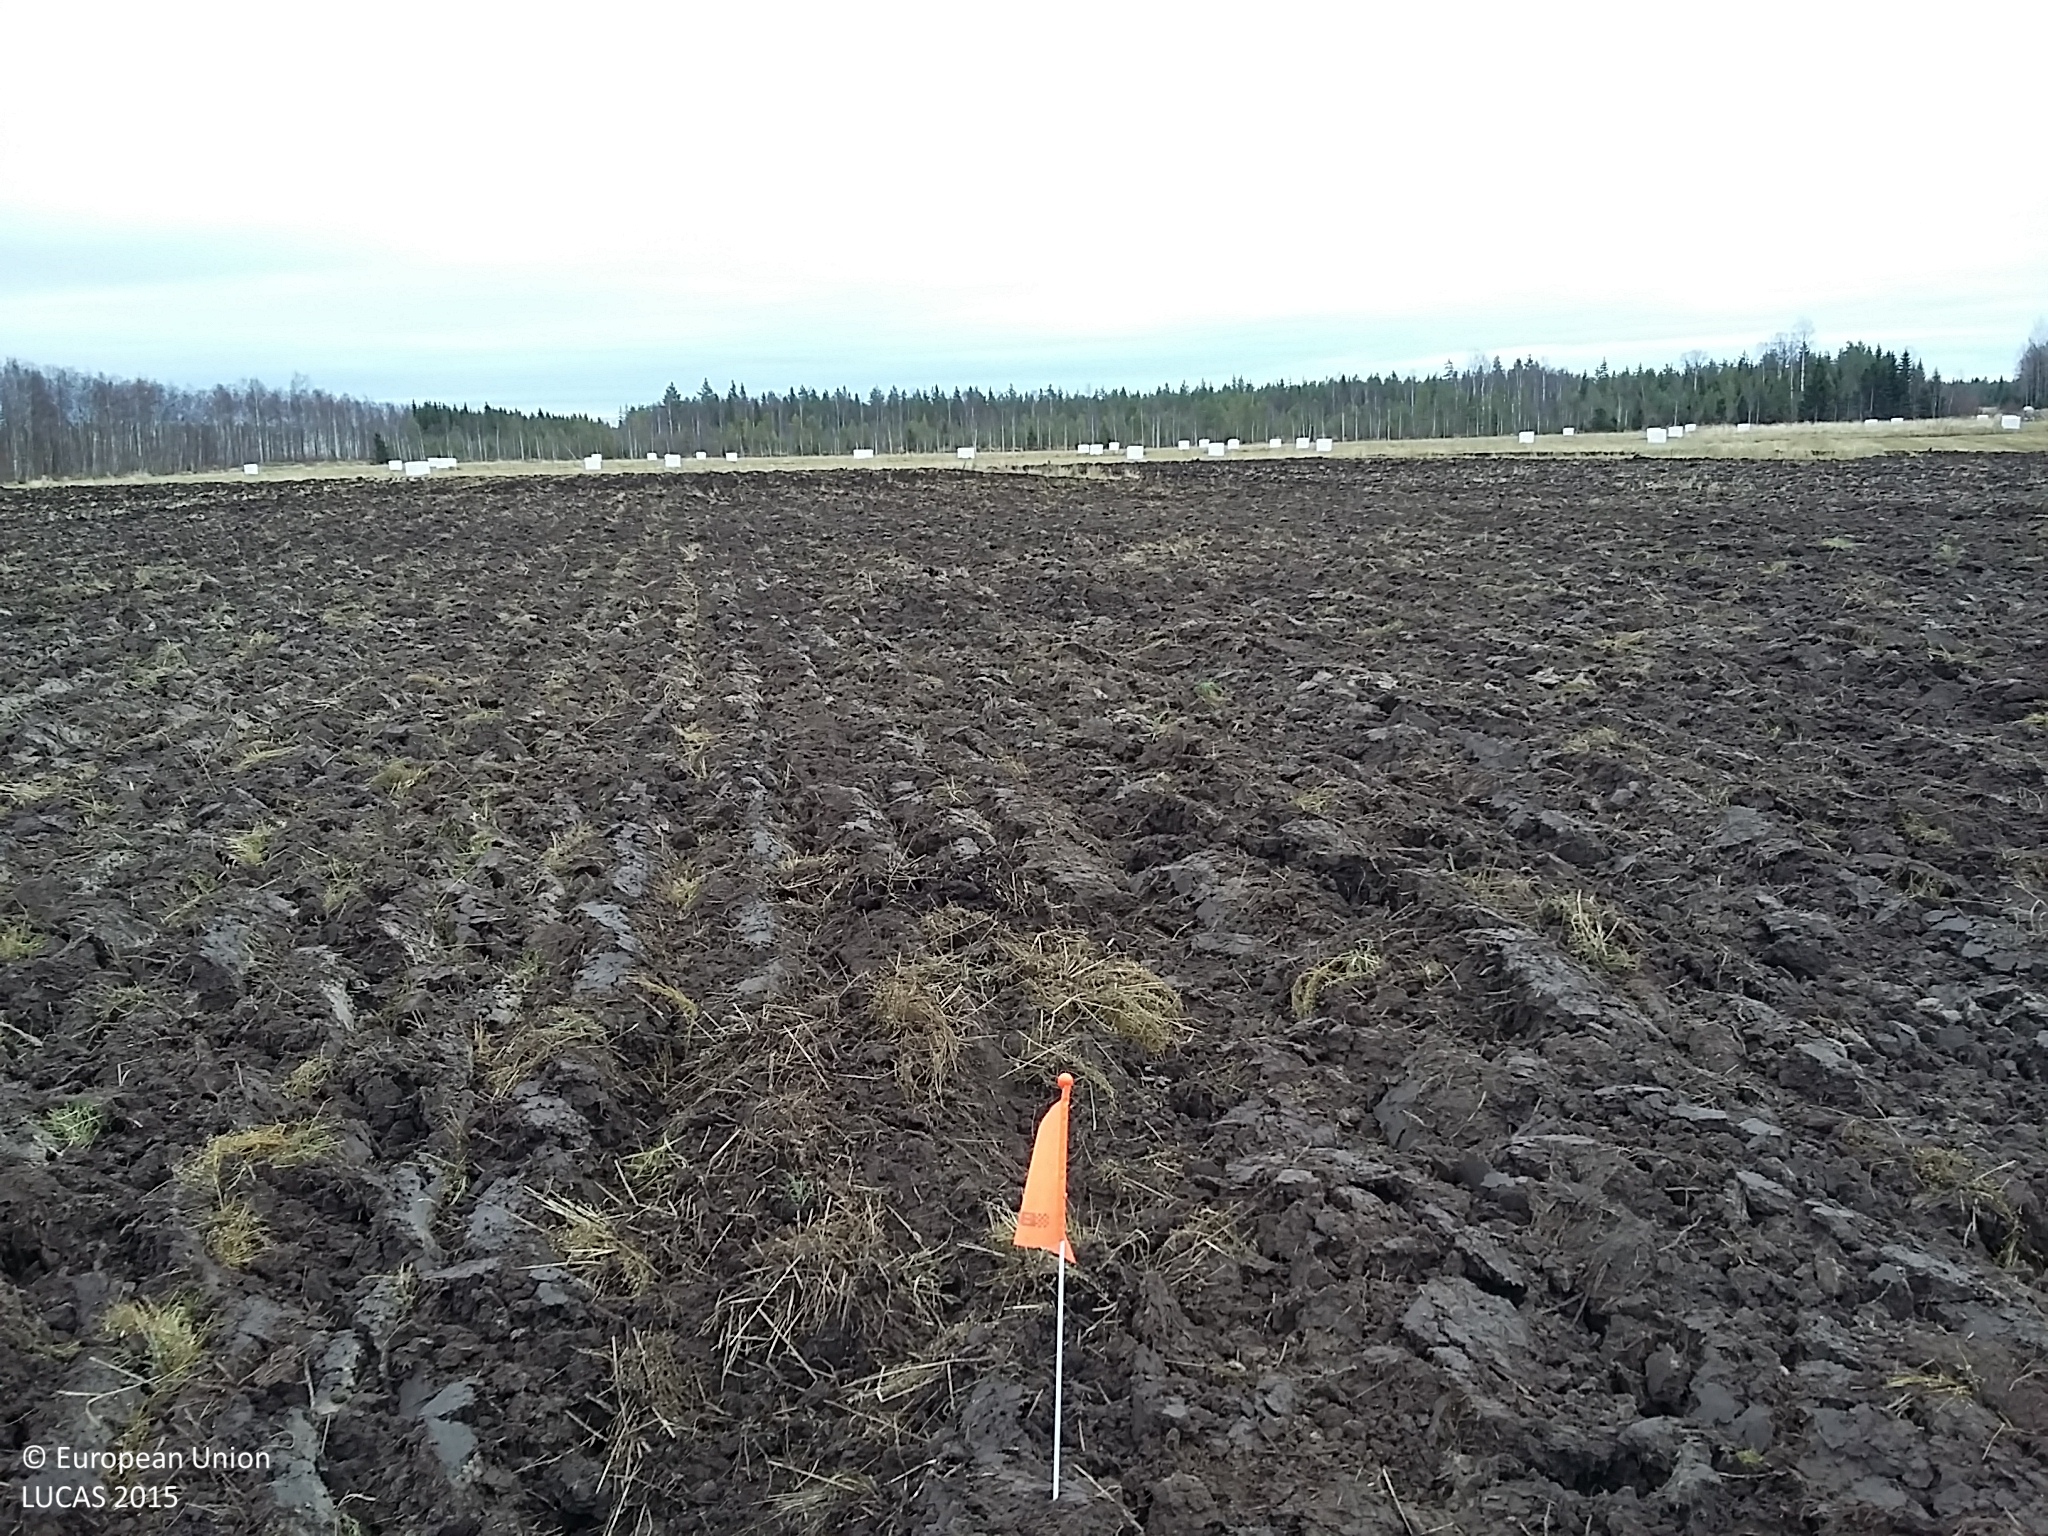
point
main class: Cropland
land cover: Oats
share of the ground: < 10 %
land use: Agriculture (excluding fallow land and kitchen gardens)
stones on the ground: < 10 %
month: October
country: FI
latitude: 64.6844
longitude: 25.4930
